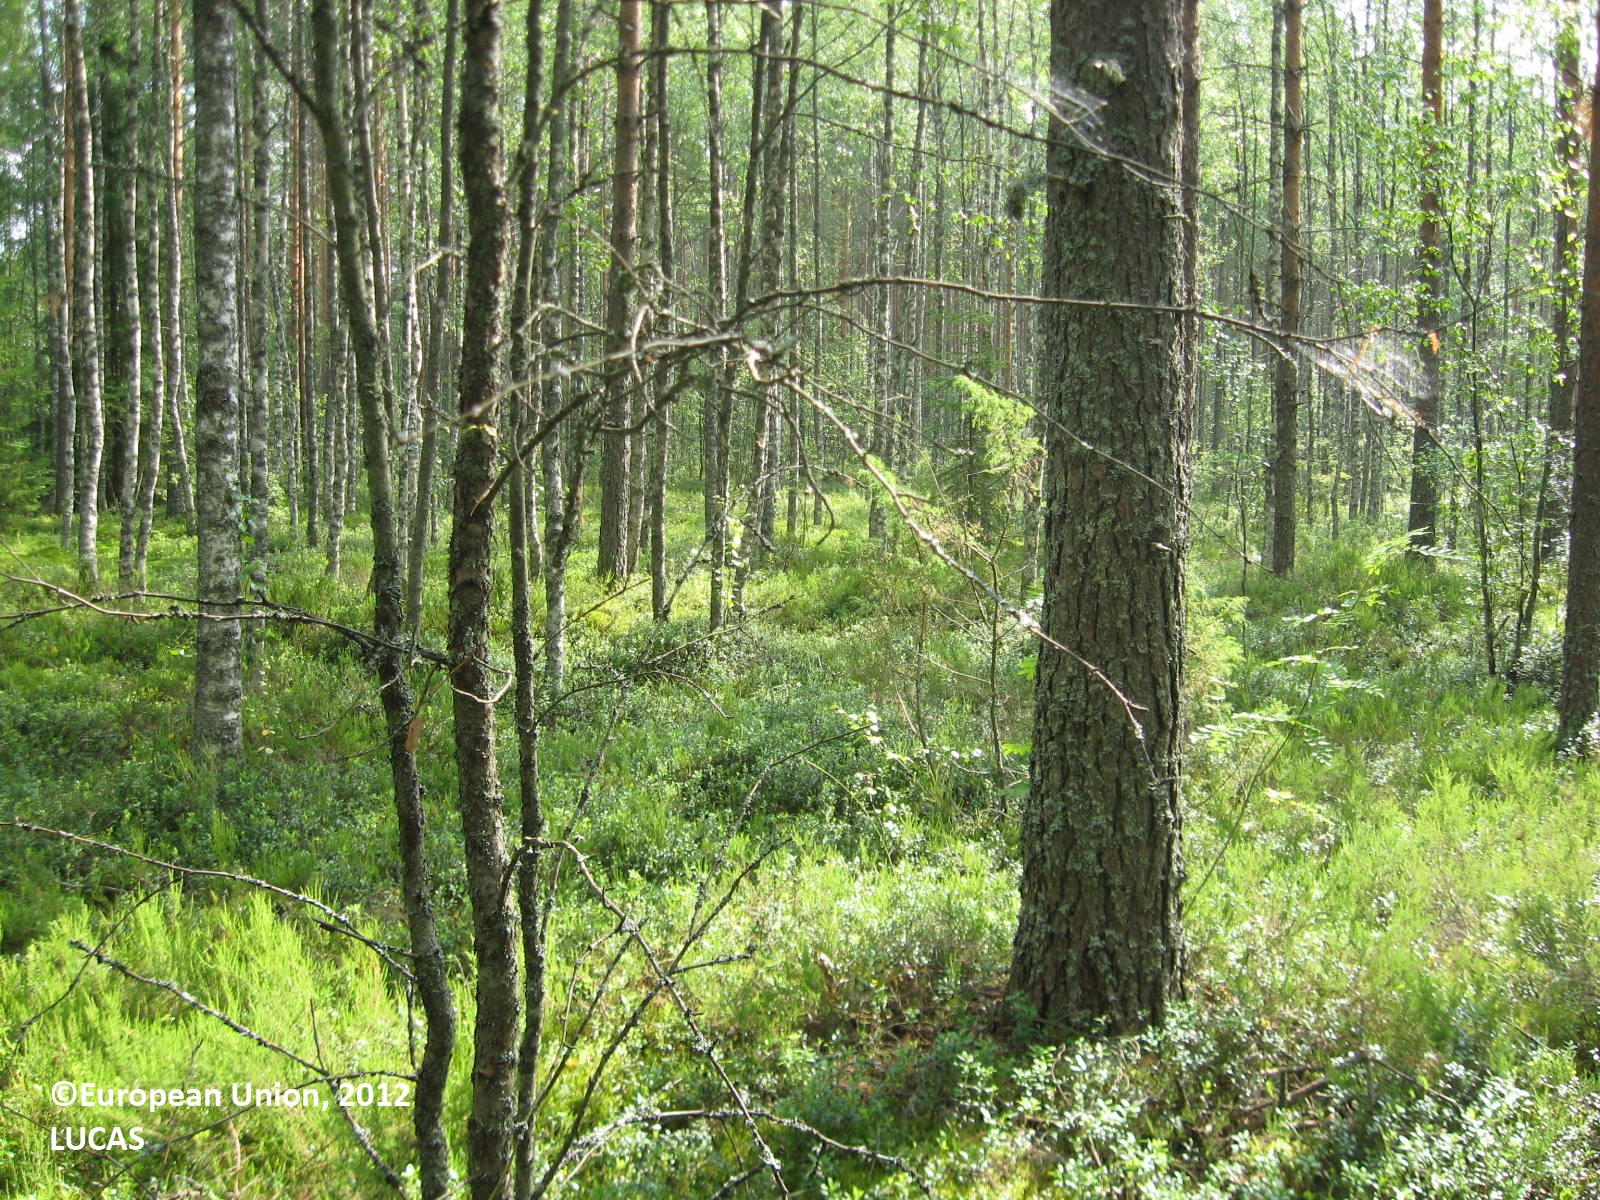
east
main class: Woodland
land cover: Pine dominated mixed woodland
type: boreal forest
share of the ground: > 75 %
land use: Forestry
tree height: > 5 m
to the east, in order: Pine dominated mixed woodland; Ditches and canals; Other mixed woodland; Pine dominated mixed woodland; Pine dominated coniferous woodland; Pine dominated mixed woodland
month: July
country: FI
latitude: 61.8987
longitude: 22.3715
